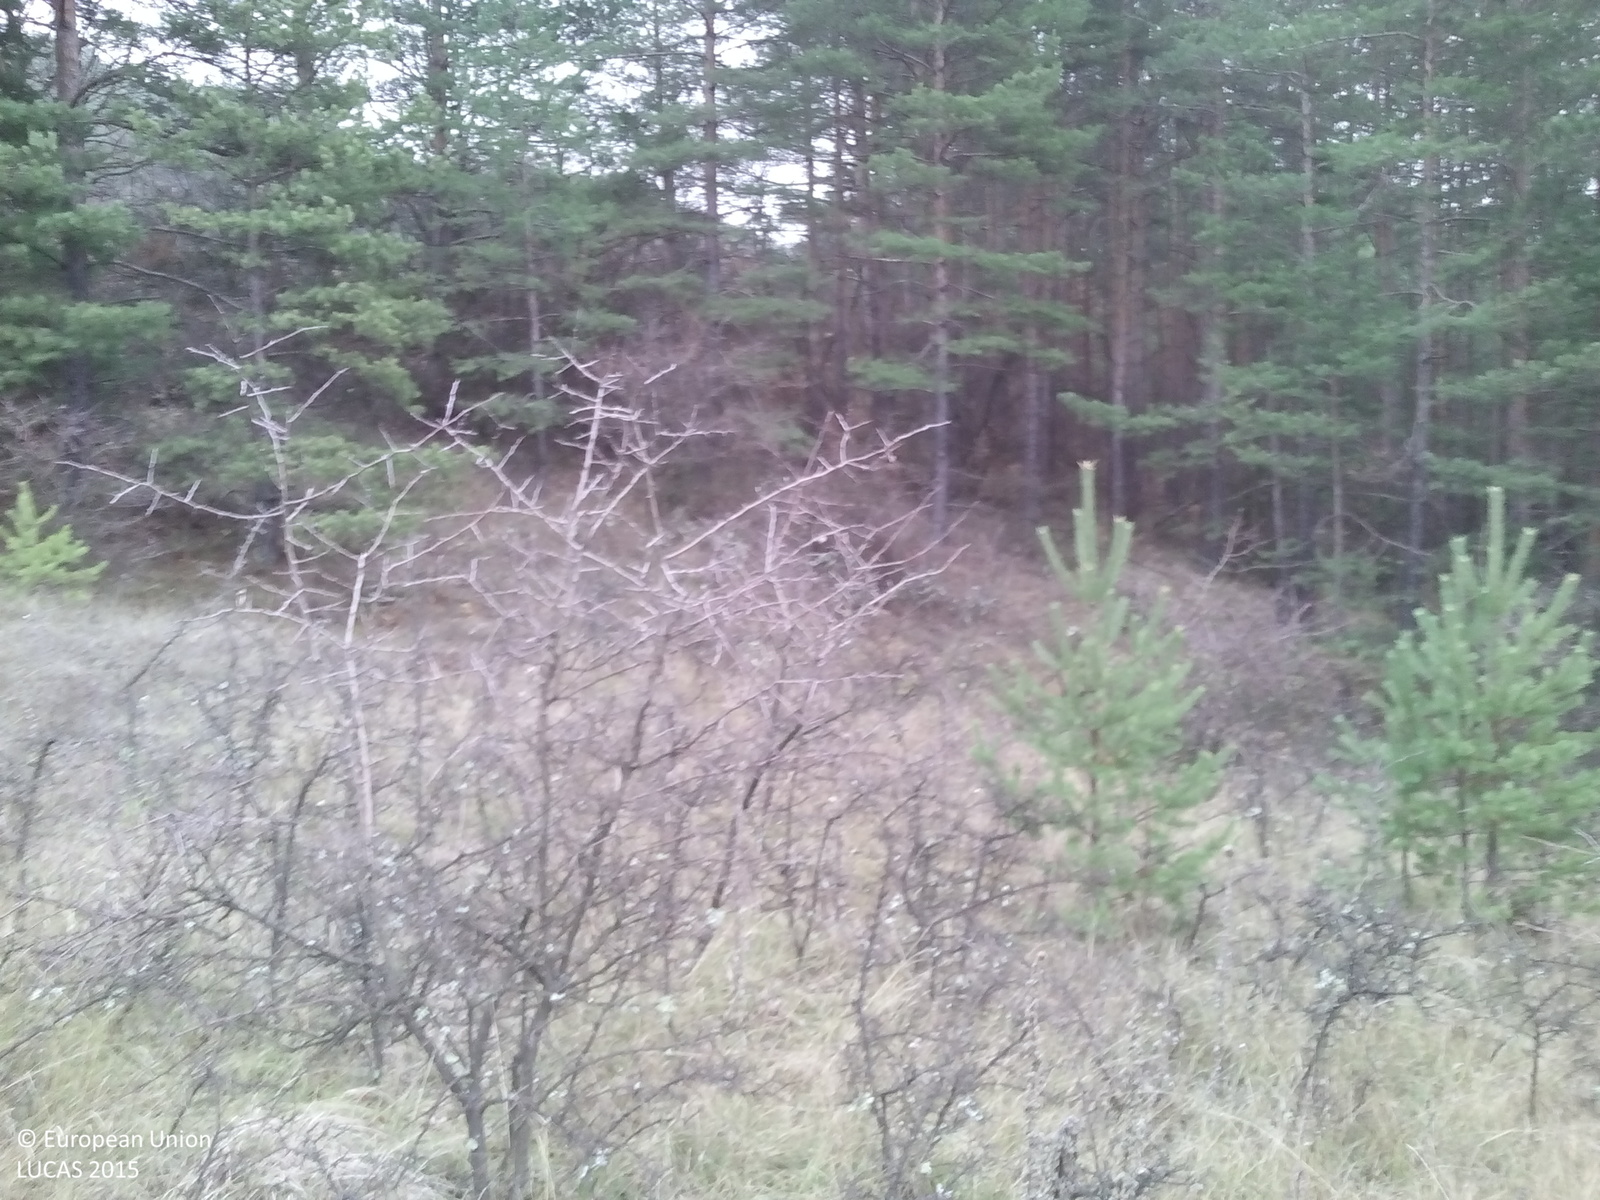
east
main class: Shrubland
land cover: Shrubland with sparse tree cover
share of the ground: 25 - 50 %
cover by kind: herbaceous plants 55 %, shrubs 40 %, coniferous forest trees 5 %
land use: Semi-natural and natural areas not in use
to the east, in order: Shrubland with sparse tree cover; Pine dominated coniferous woodland; Shrubland without tree cover; Grassland without tree/shrub cover; Pine dominated coniferous woodland
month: December
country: BG
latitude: 42.7959
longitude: 22.8789
